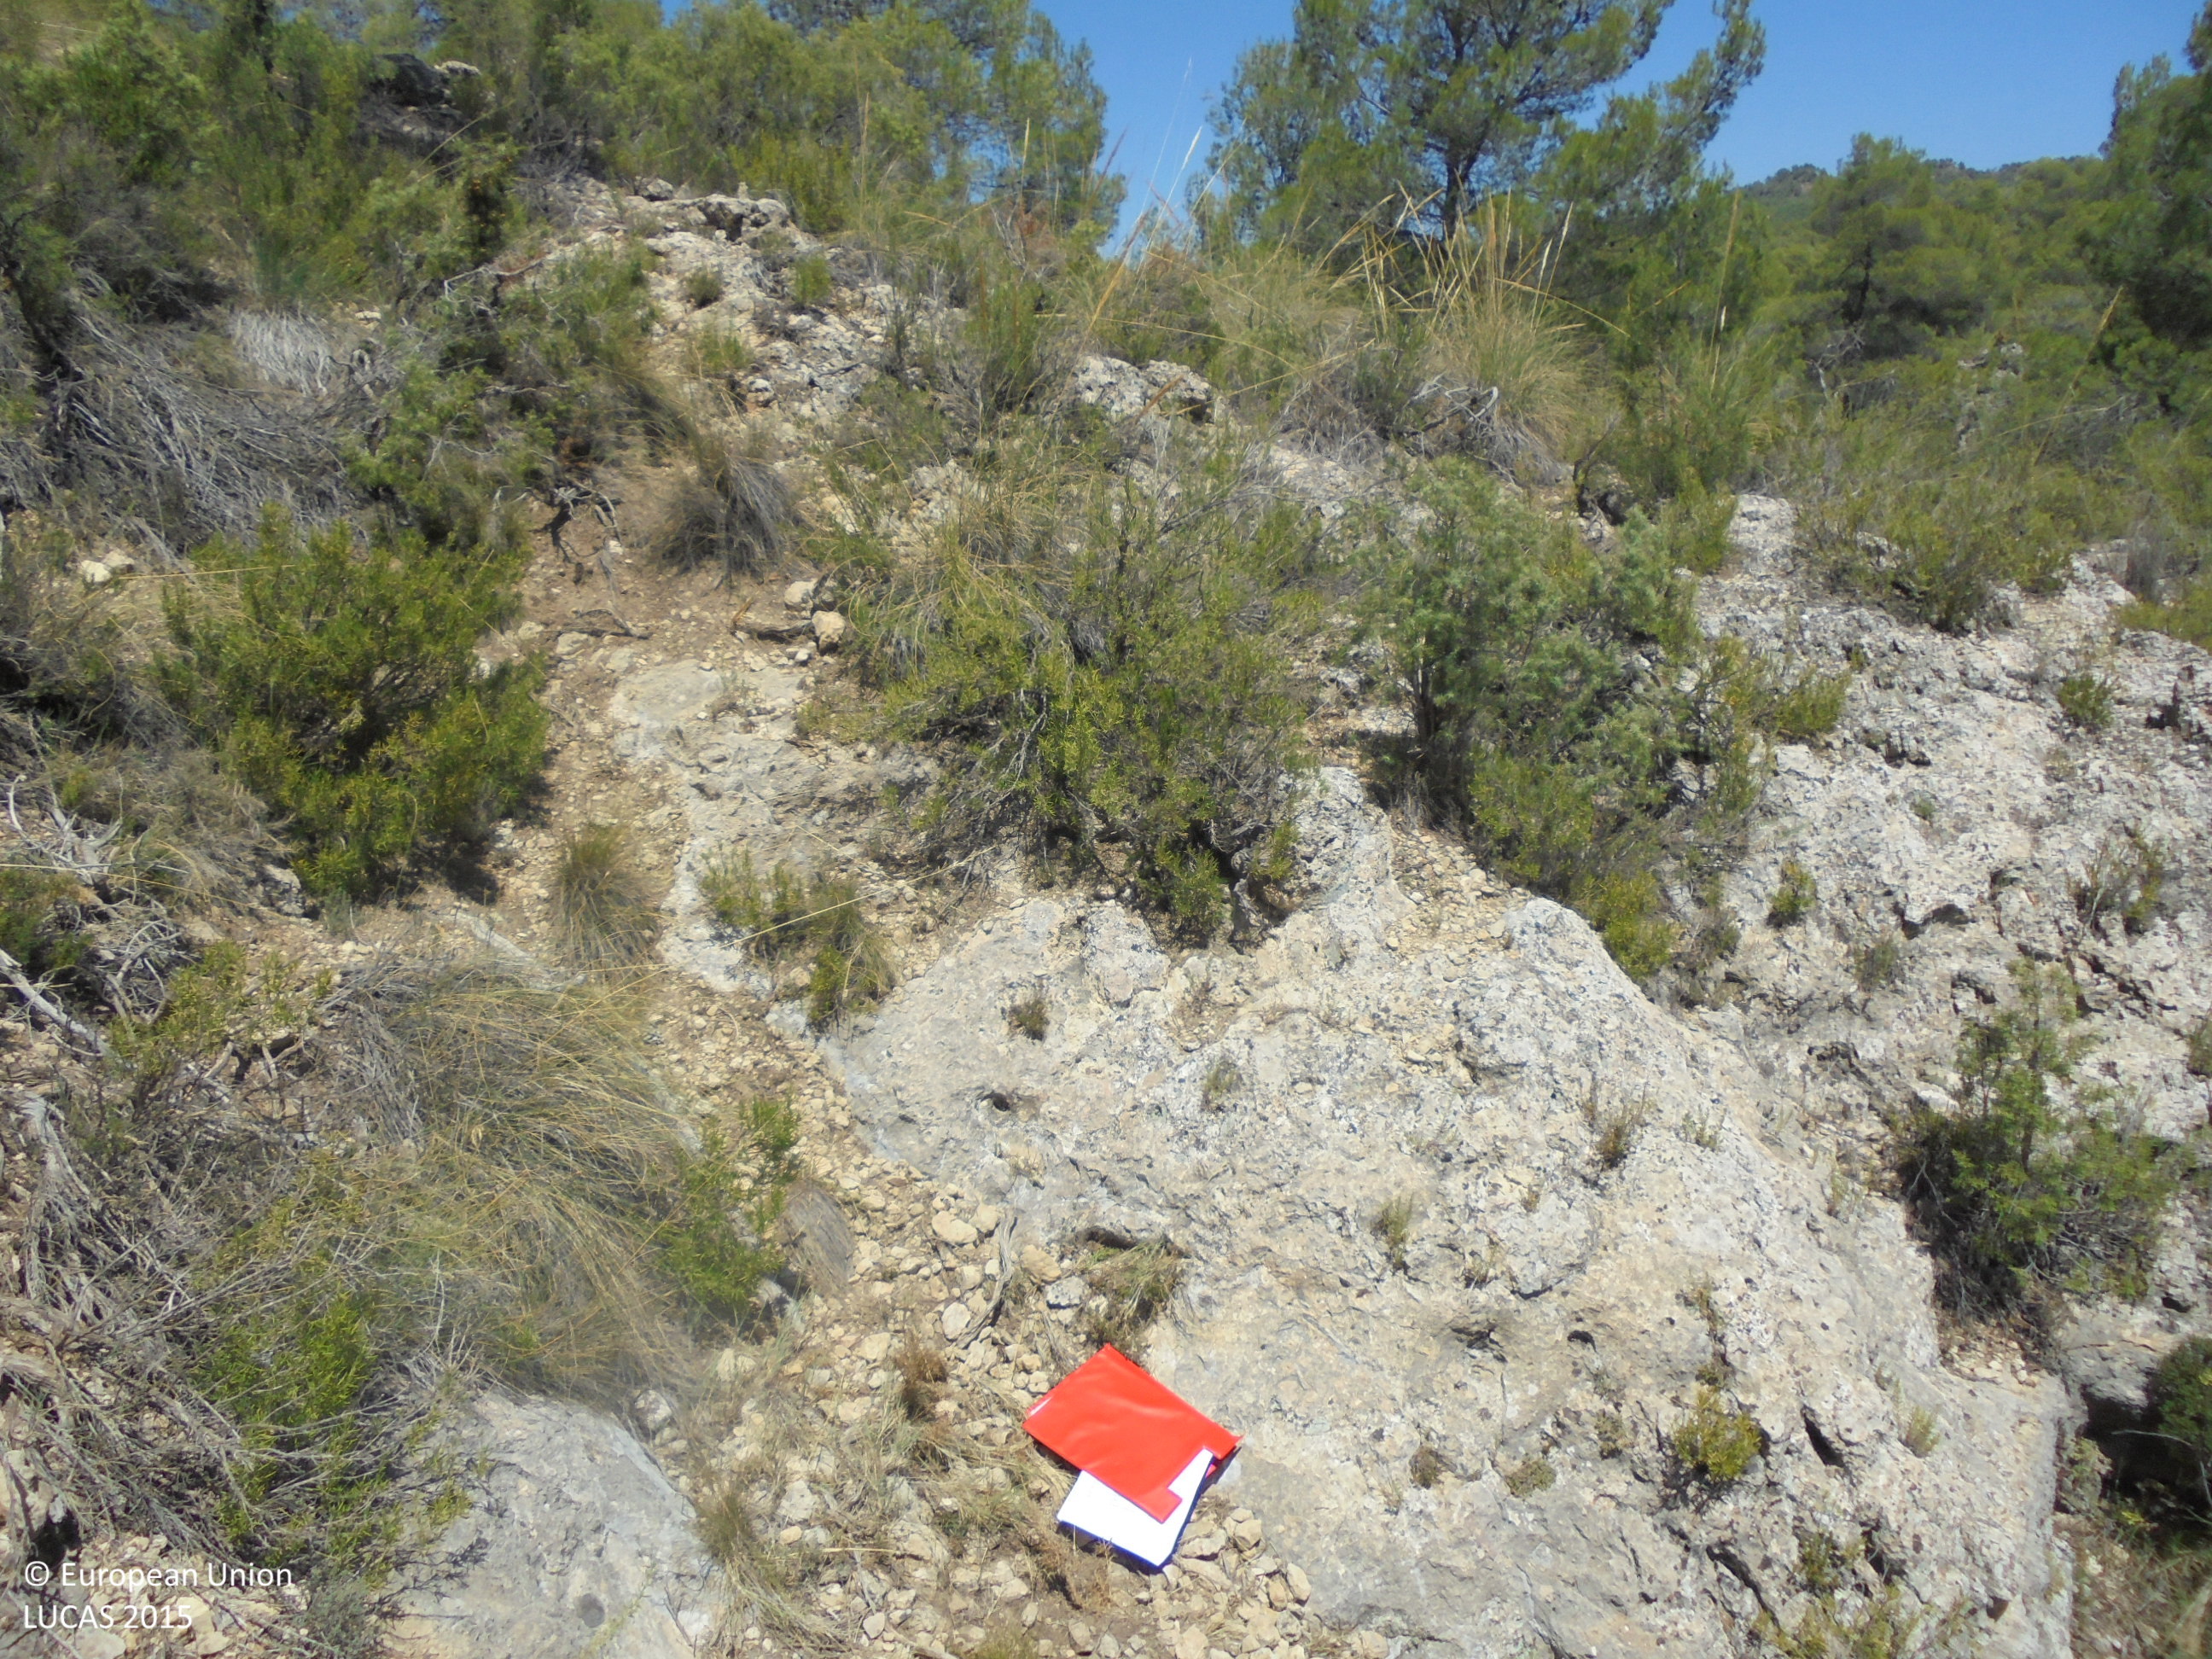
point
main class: Woodland
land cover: Pine dominated coniferous woodland
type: coniferous forest of the mediterranean region
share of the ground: 25 - 50 %
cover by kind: shrubs 50 %, coniferous forest trees 30 %, consolidated bare surface 10 %, unconsolidated bare surface 10 %
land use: Semi-natural and natural areas not in use
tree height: > 5 m
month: July
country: ES
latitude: 38.9669
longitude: -1.0400
